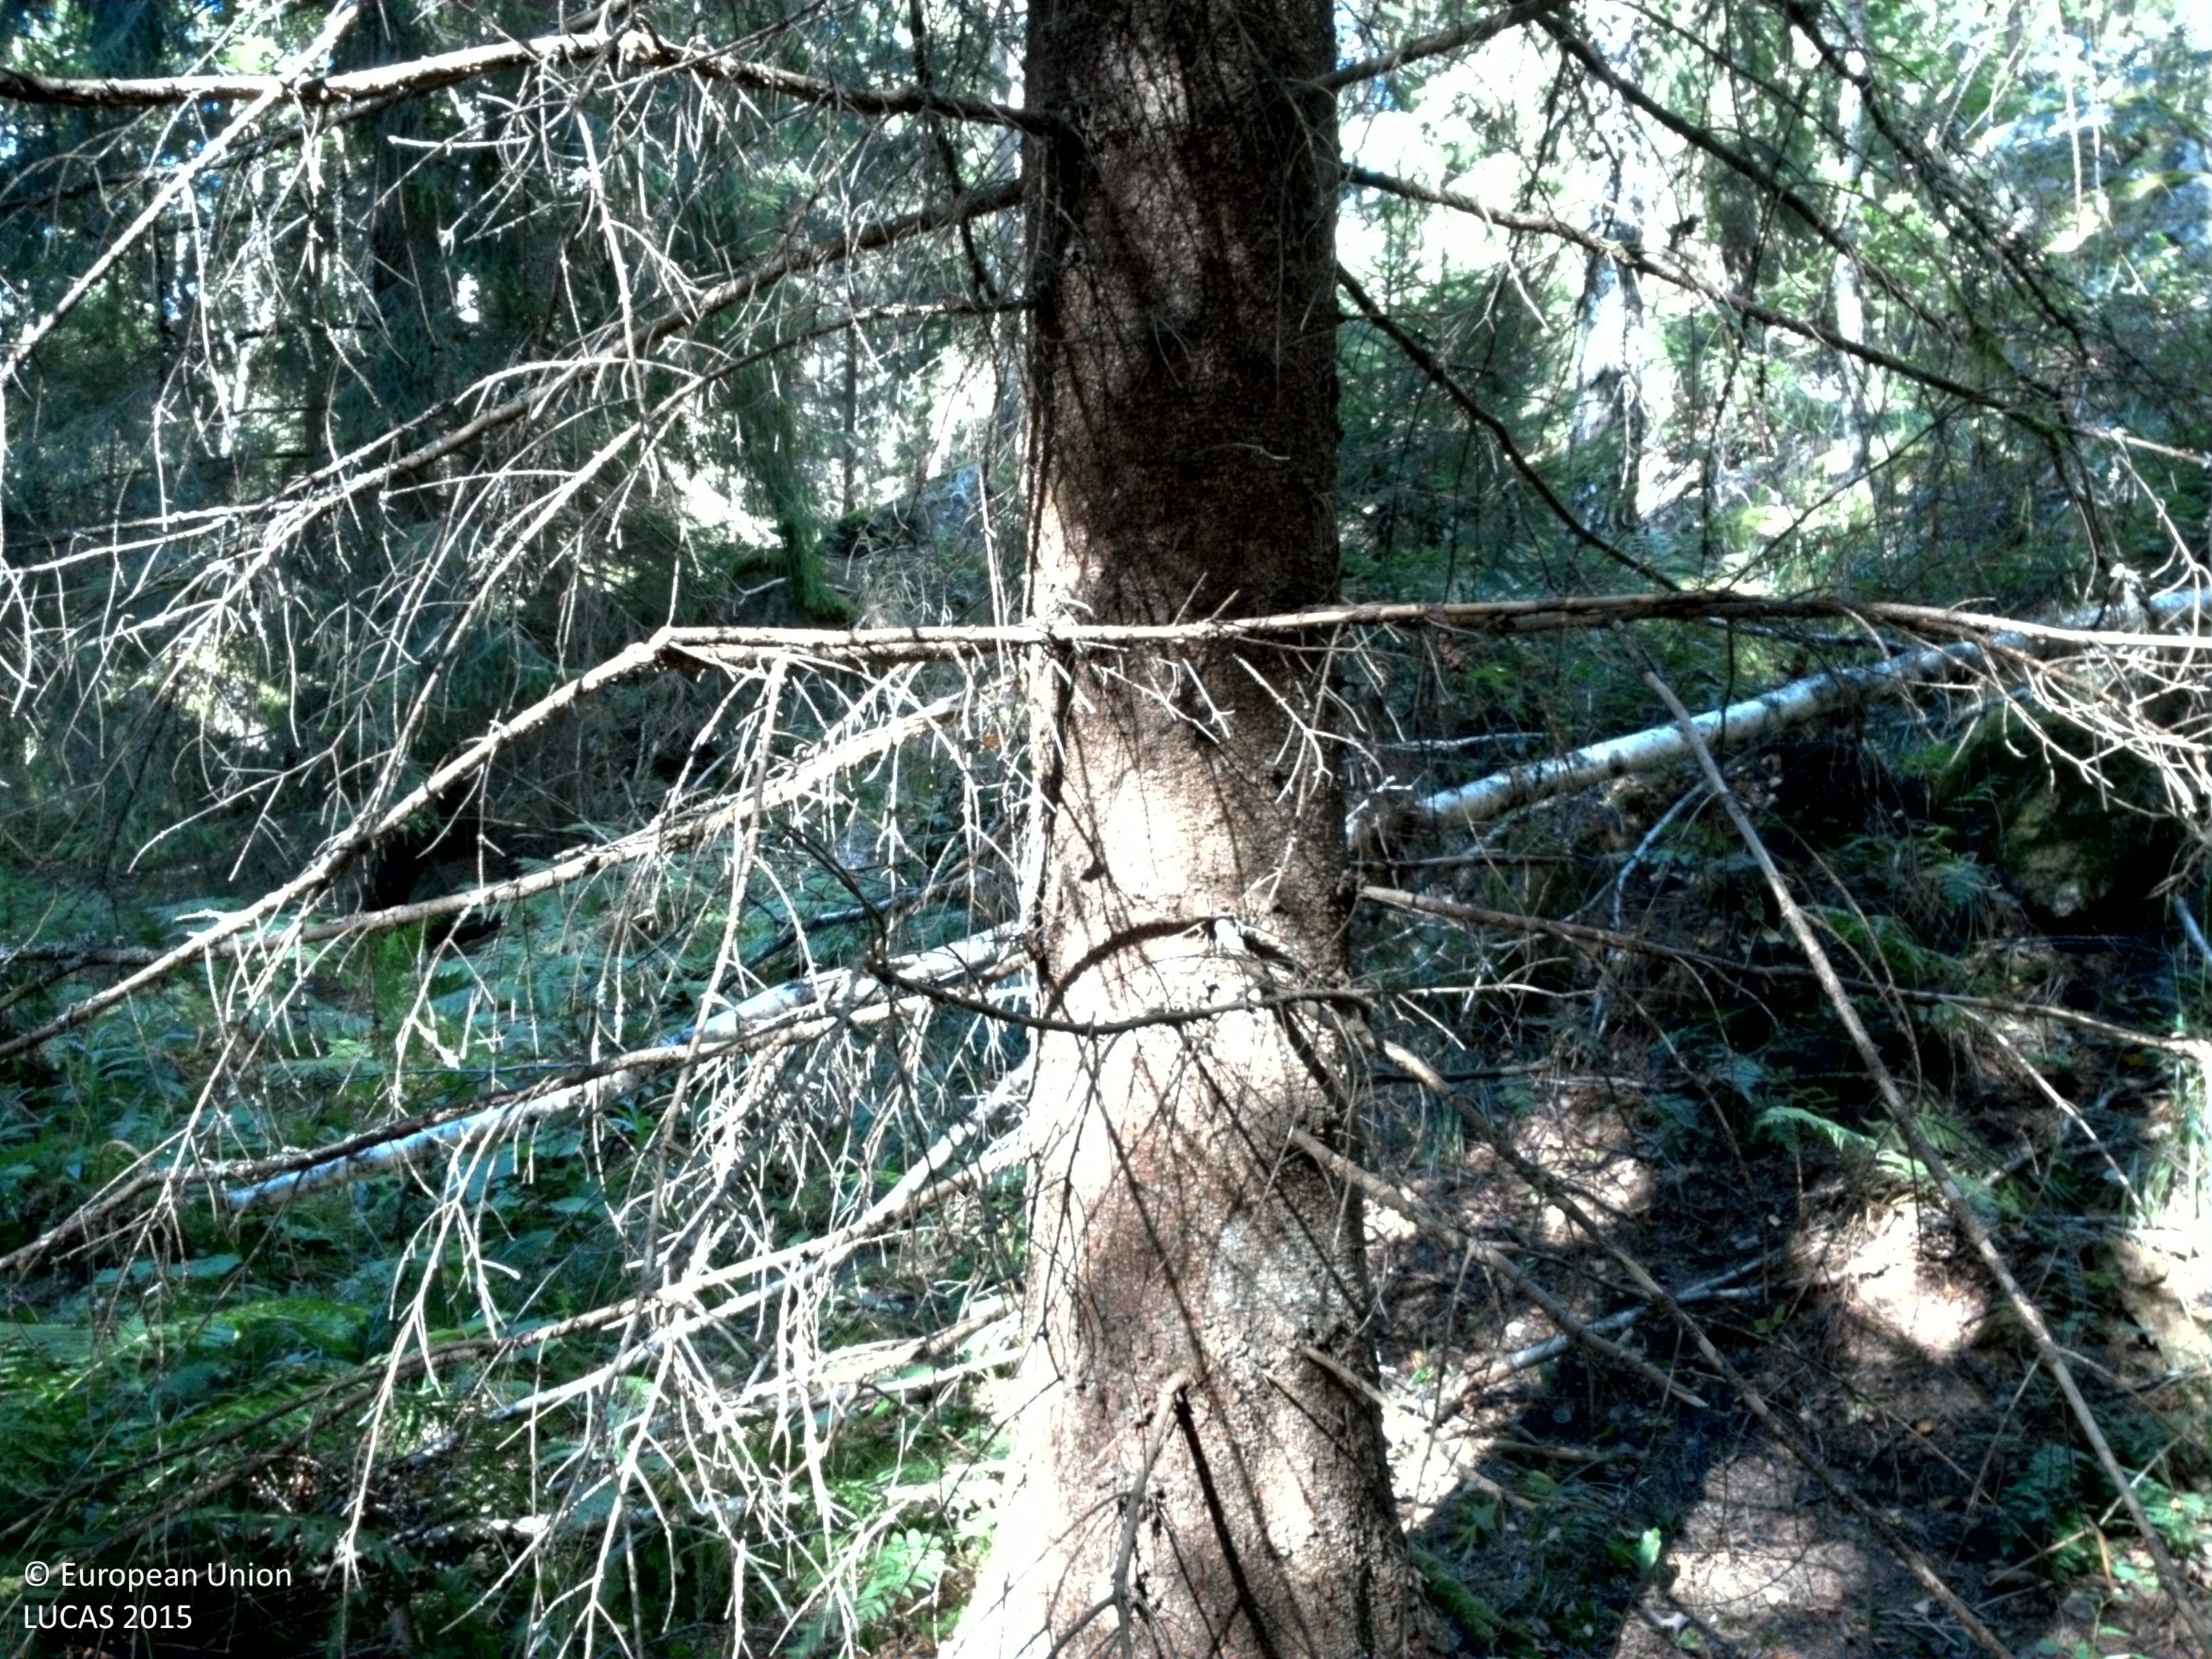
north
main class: Woodland
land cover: Spruce dominated coniferous woodland
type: boreal forest
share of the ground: > 75 %
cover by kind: coniferous forest trees 80 %, broadleaved forest trees 5 %, herbaceous plants 5 %, lichens and mosses 5 %, unconsolidated bare surface 5 %
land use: Forestry
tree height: > 5 m
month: August
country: SE
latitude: 59.9753
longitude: 17.9322
